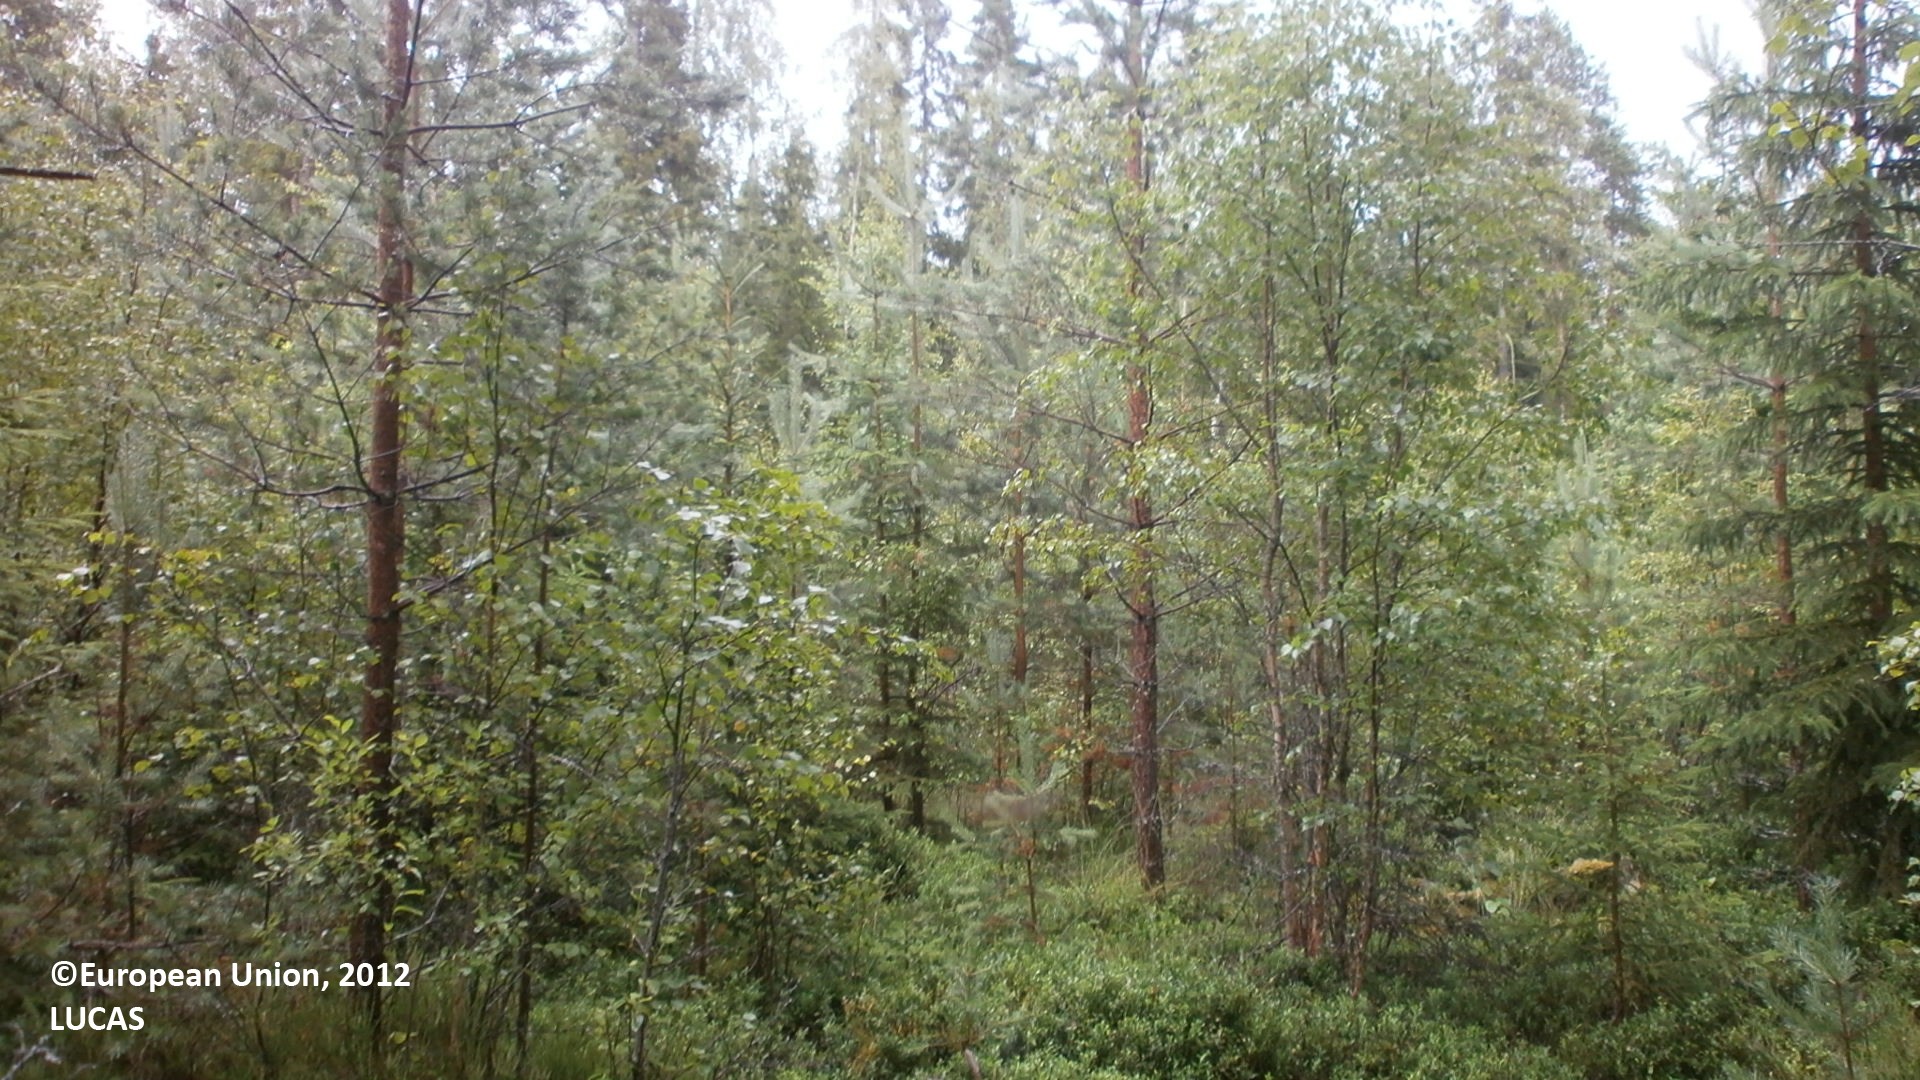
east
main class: Woodland
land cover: Spruce dominated mixed woodland
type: boreal forest
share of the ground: > 75 %
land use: Forestry
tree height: > 5 m
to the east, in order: Spruce dominated mixed woodland; Pine dominated mixed woodland; Ditches and canals; Spruce dominated mixed woodland; Spruce dominated coniferous woodland; Pine dominated coniferous woodland; Spruce dominated coniferous woodland
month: July
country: FI
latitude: 64.0522
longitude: 23.7646
